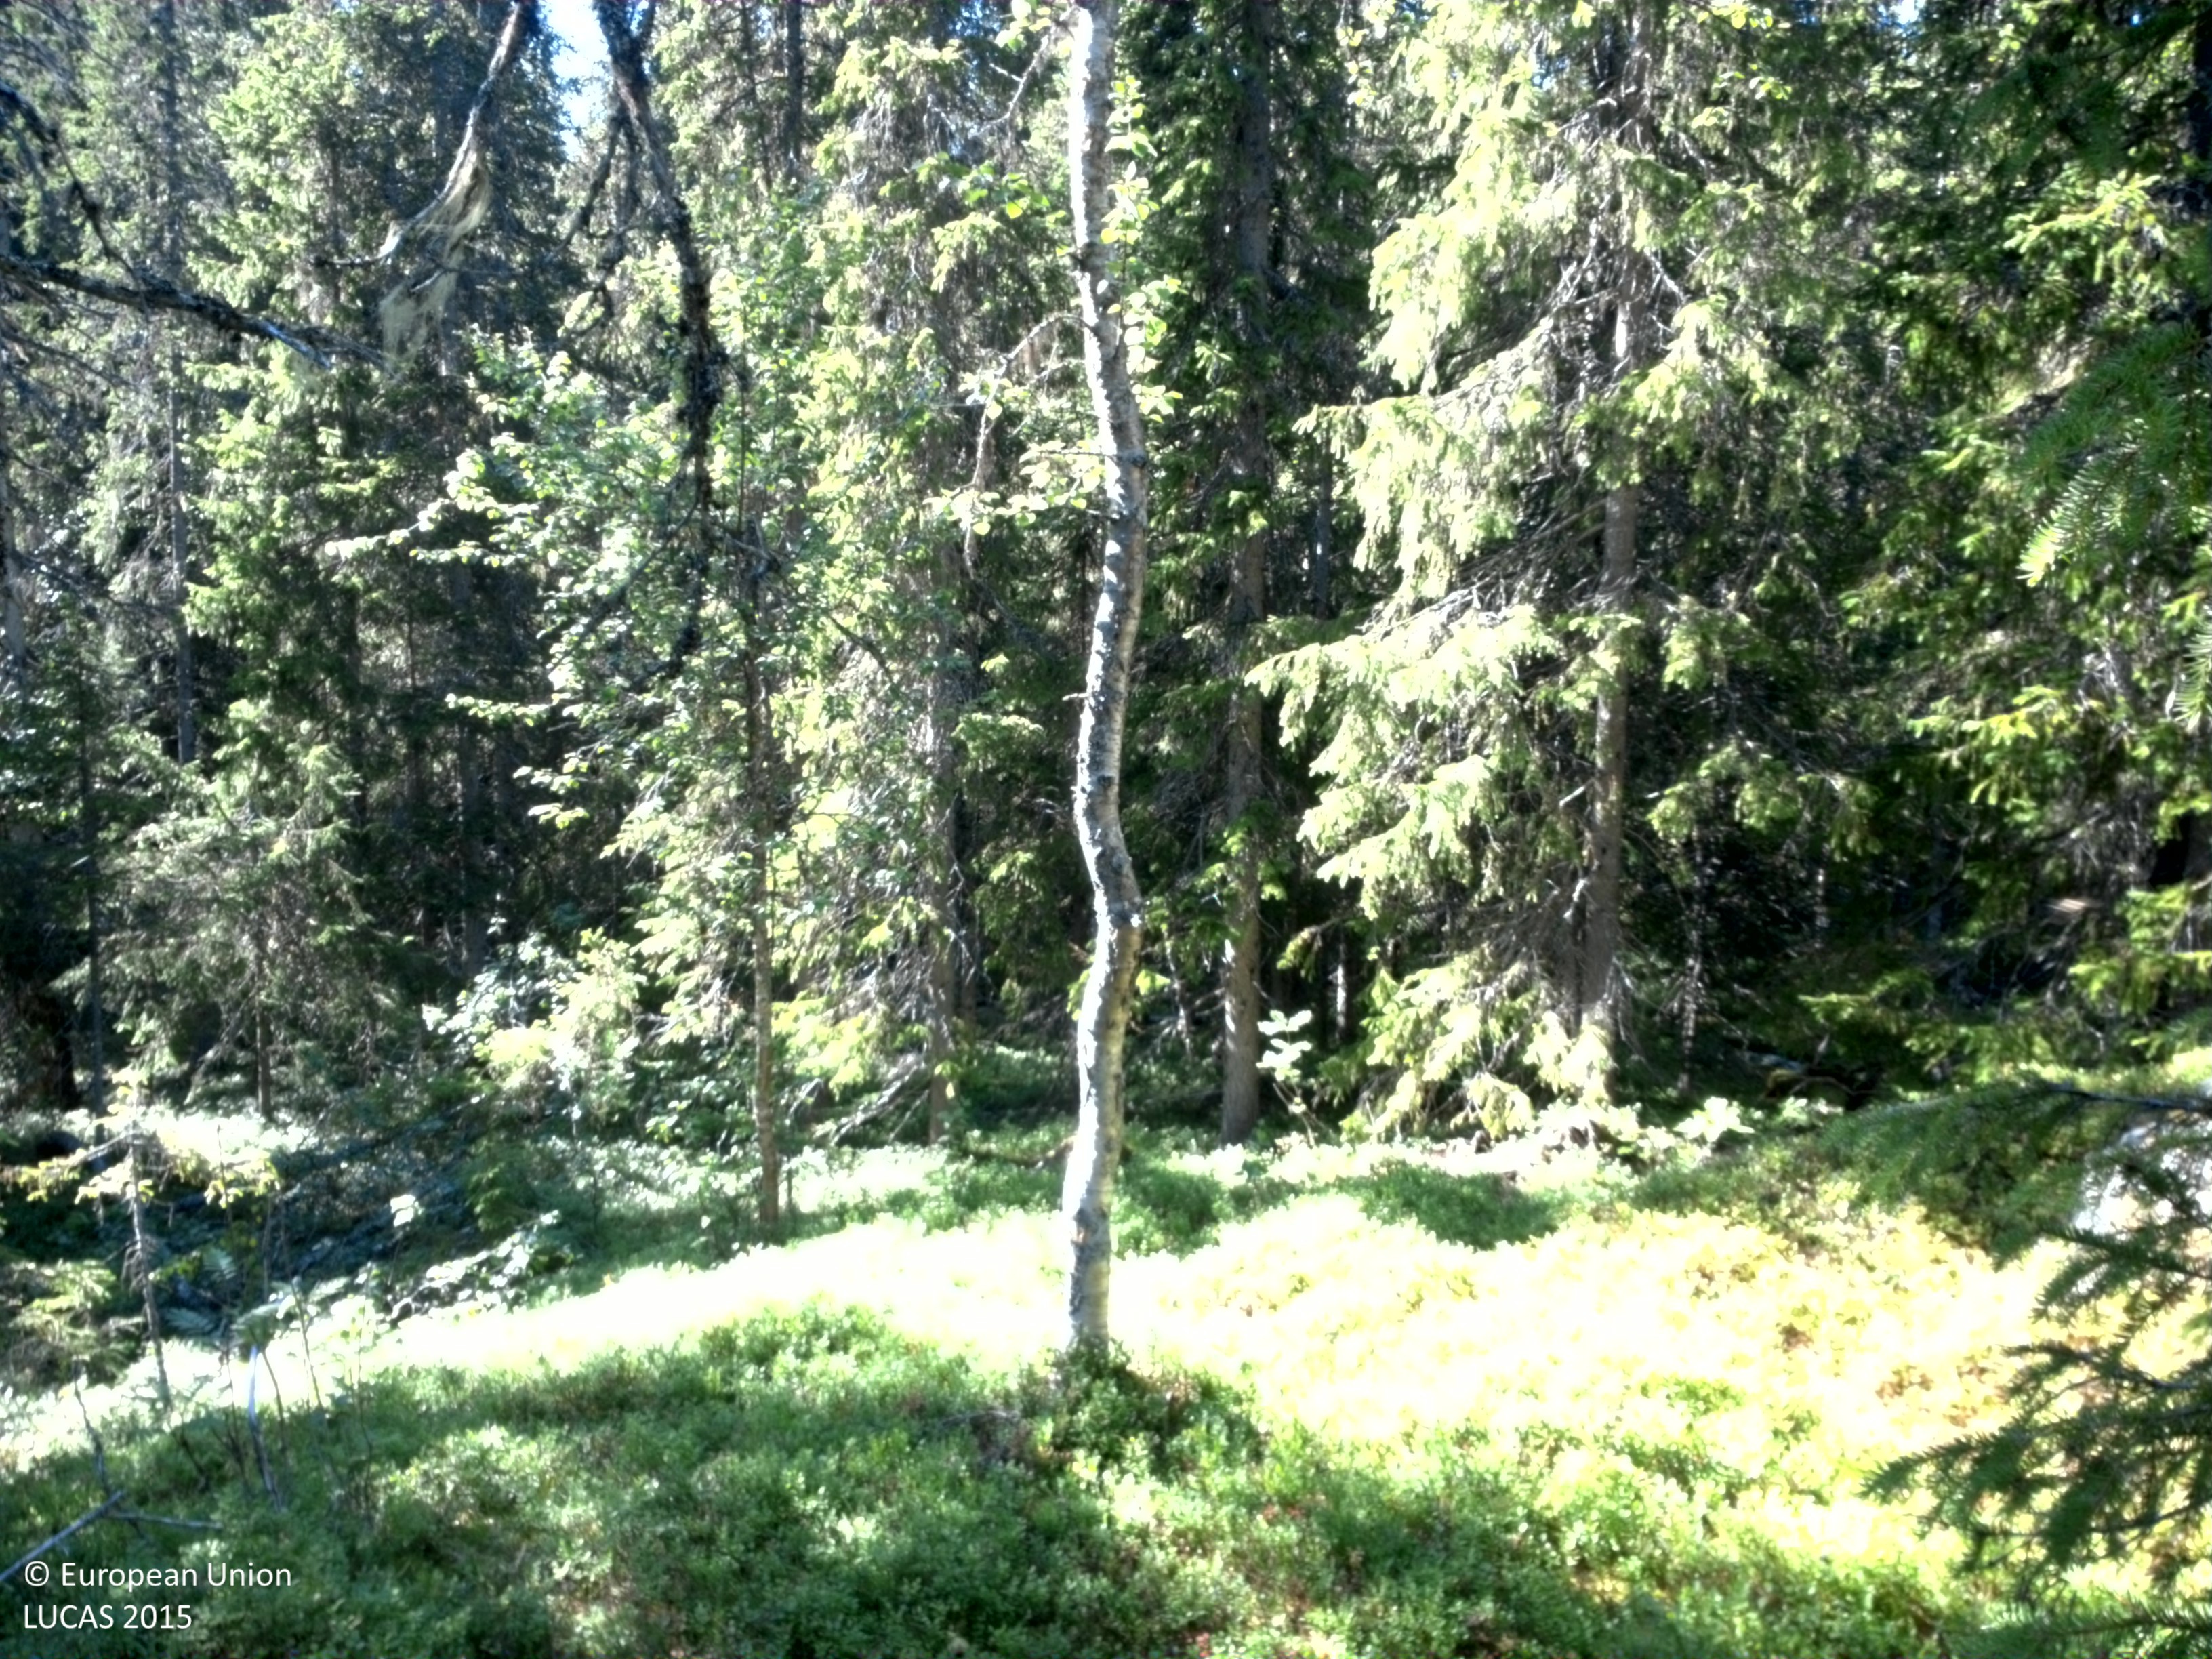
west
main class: Woodland
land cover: Spruce dominated coniferous woodland
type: boreal forest
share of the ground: 25 - 50 %
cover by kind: shrubs 50 %, coniferous forest trees 35 %, lichens and mosses 15 %
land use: Forestry
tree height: > 5 m
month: August
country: SE
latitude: 64.8728
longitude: 15.7715
